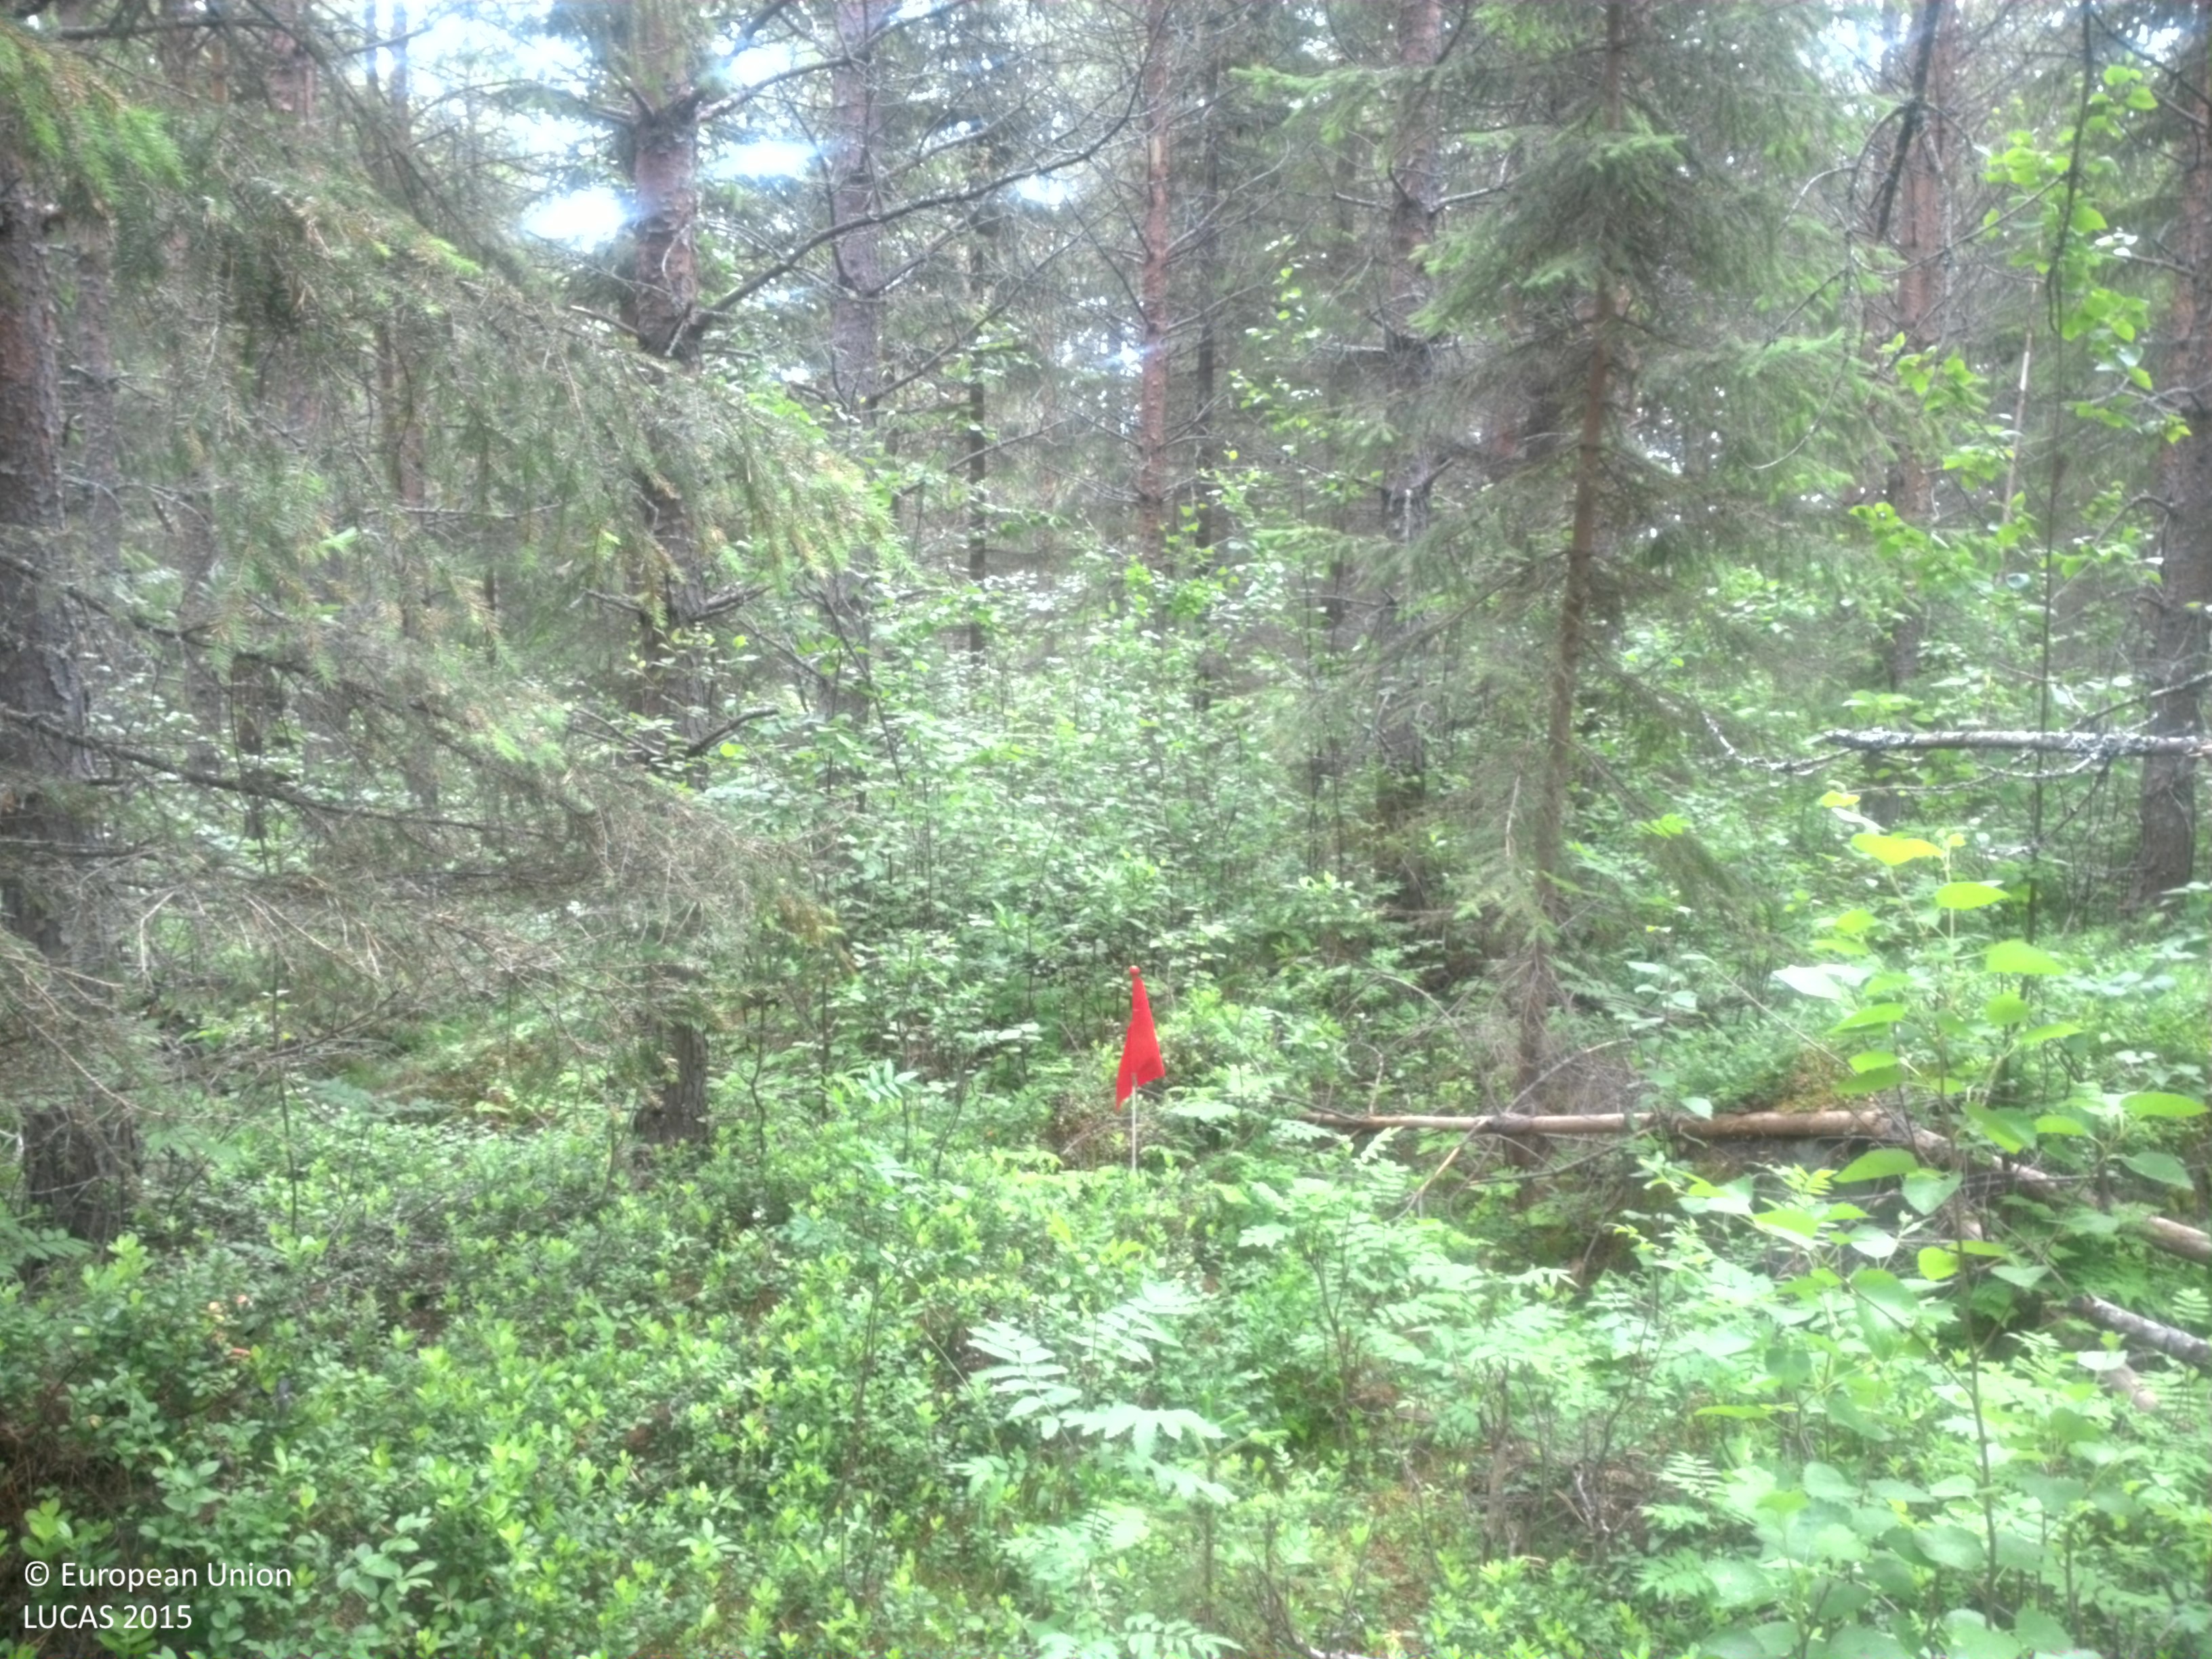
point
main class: Woodland
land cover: Other coniferous woodland
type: boreal forest
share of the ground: > 75 %
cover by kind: coniferous forest trees 80 %, shrubs 15 %, broadleaved forest trees 5 %
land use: Forestry
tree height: > 5 m
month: July
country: SE
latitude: 64.5361
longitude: 20.5880
